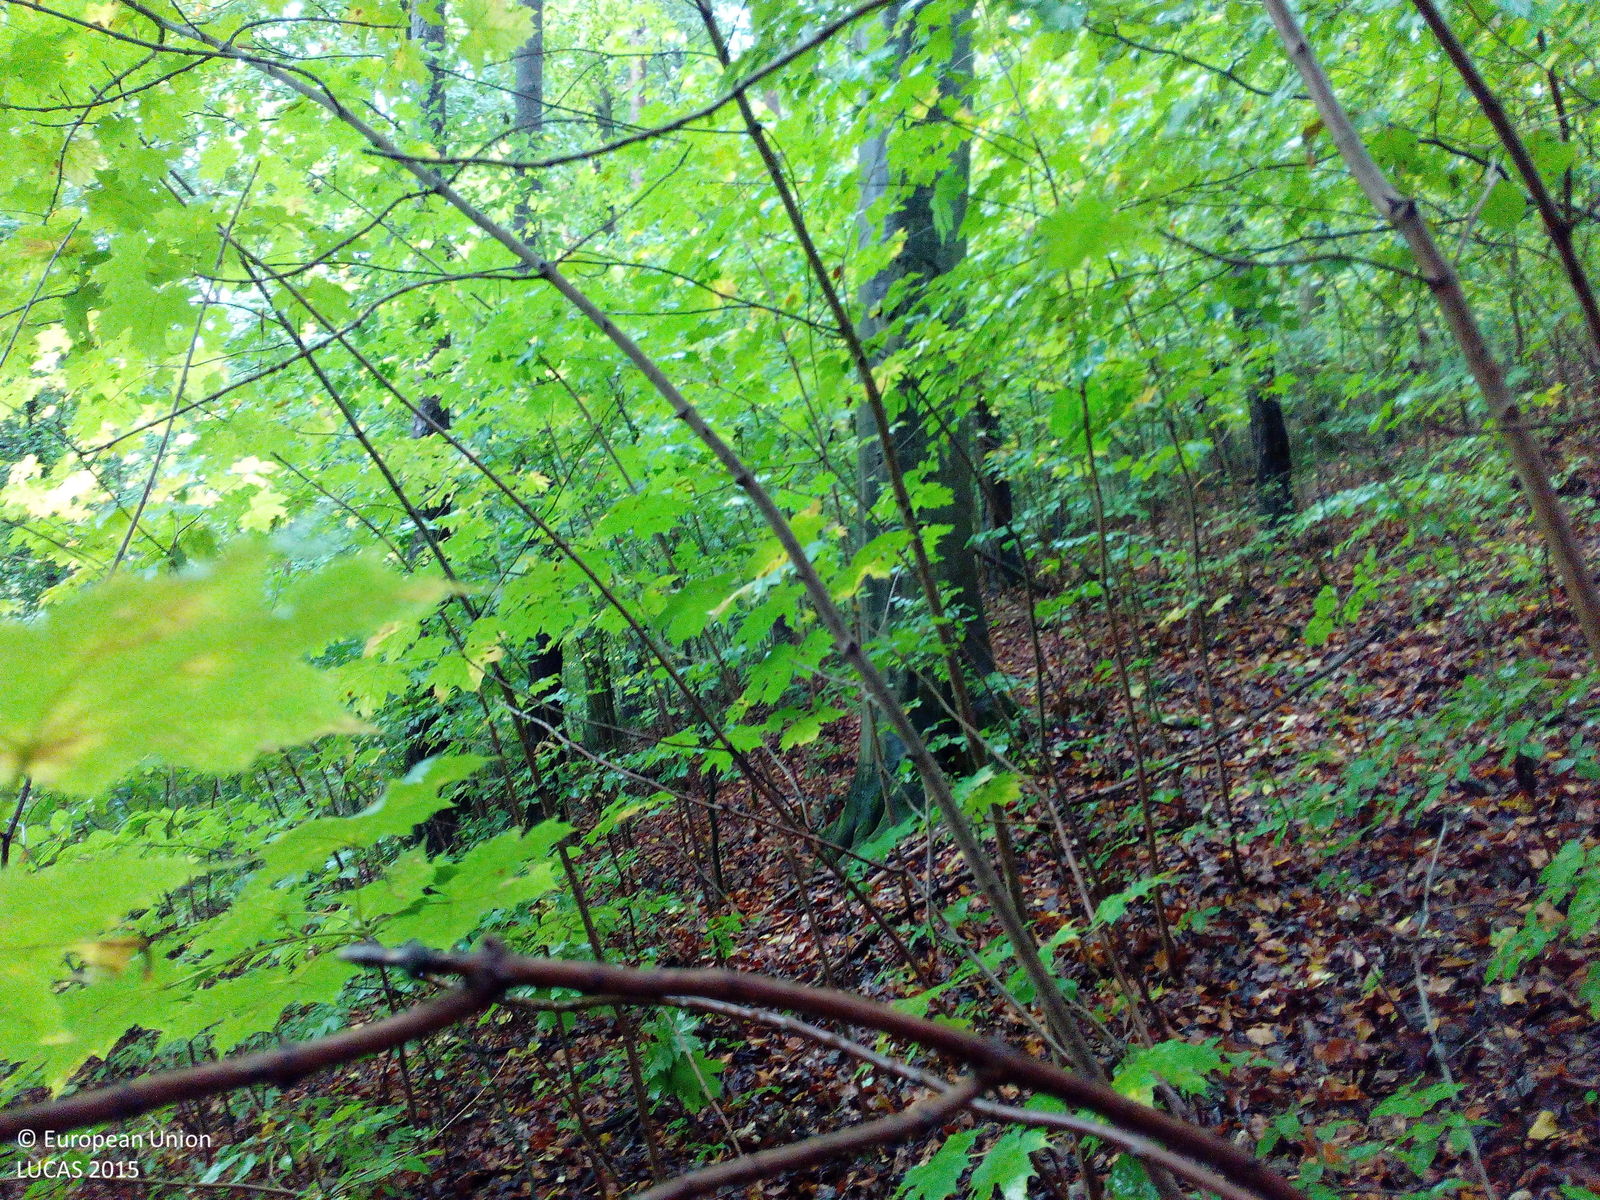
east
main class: Woodland
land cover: Broadleaved woodland
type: beech forest
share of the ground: 50 - 75 %
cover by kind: broadleaved forest trees 70 %, unconsolidated bare surface 15 %, shrubs 10 %, herbaceous plants 5 %
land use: Forestry
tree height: > 5 m
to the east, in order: Broadleaved woodland
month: October
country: DE
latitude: 50.0943
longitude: 9.9022
